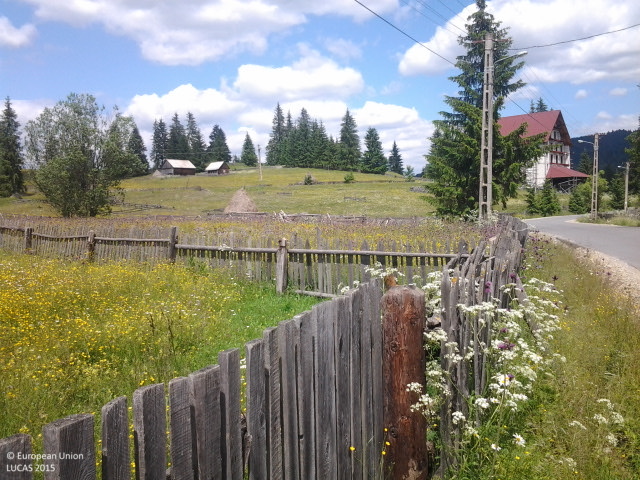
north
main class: Grassland
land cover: Grassland without tree/shrub cover
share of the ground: > 75 %
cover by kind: herbaceous plants 100 %
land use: Agriculture (excluding fallow land and kitchen gardens)
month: June
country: RO
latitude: 46.9926
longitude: 25.4837
